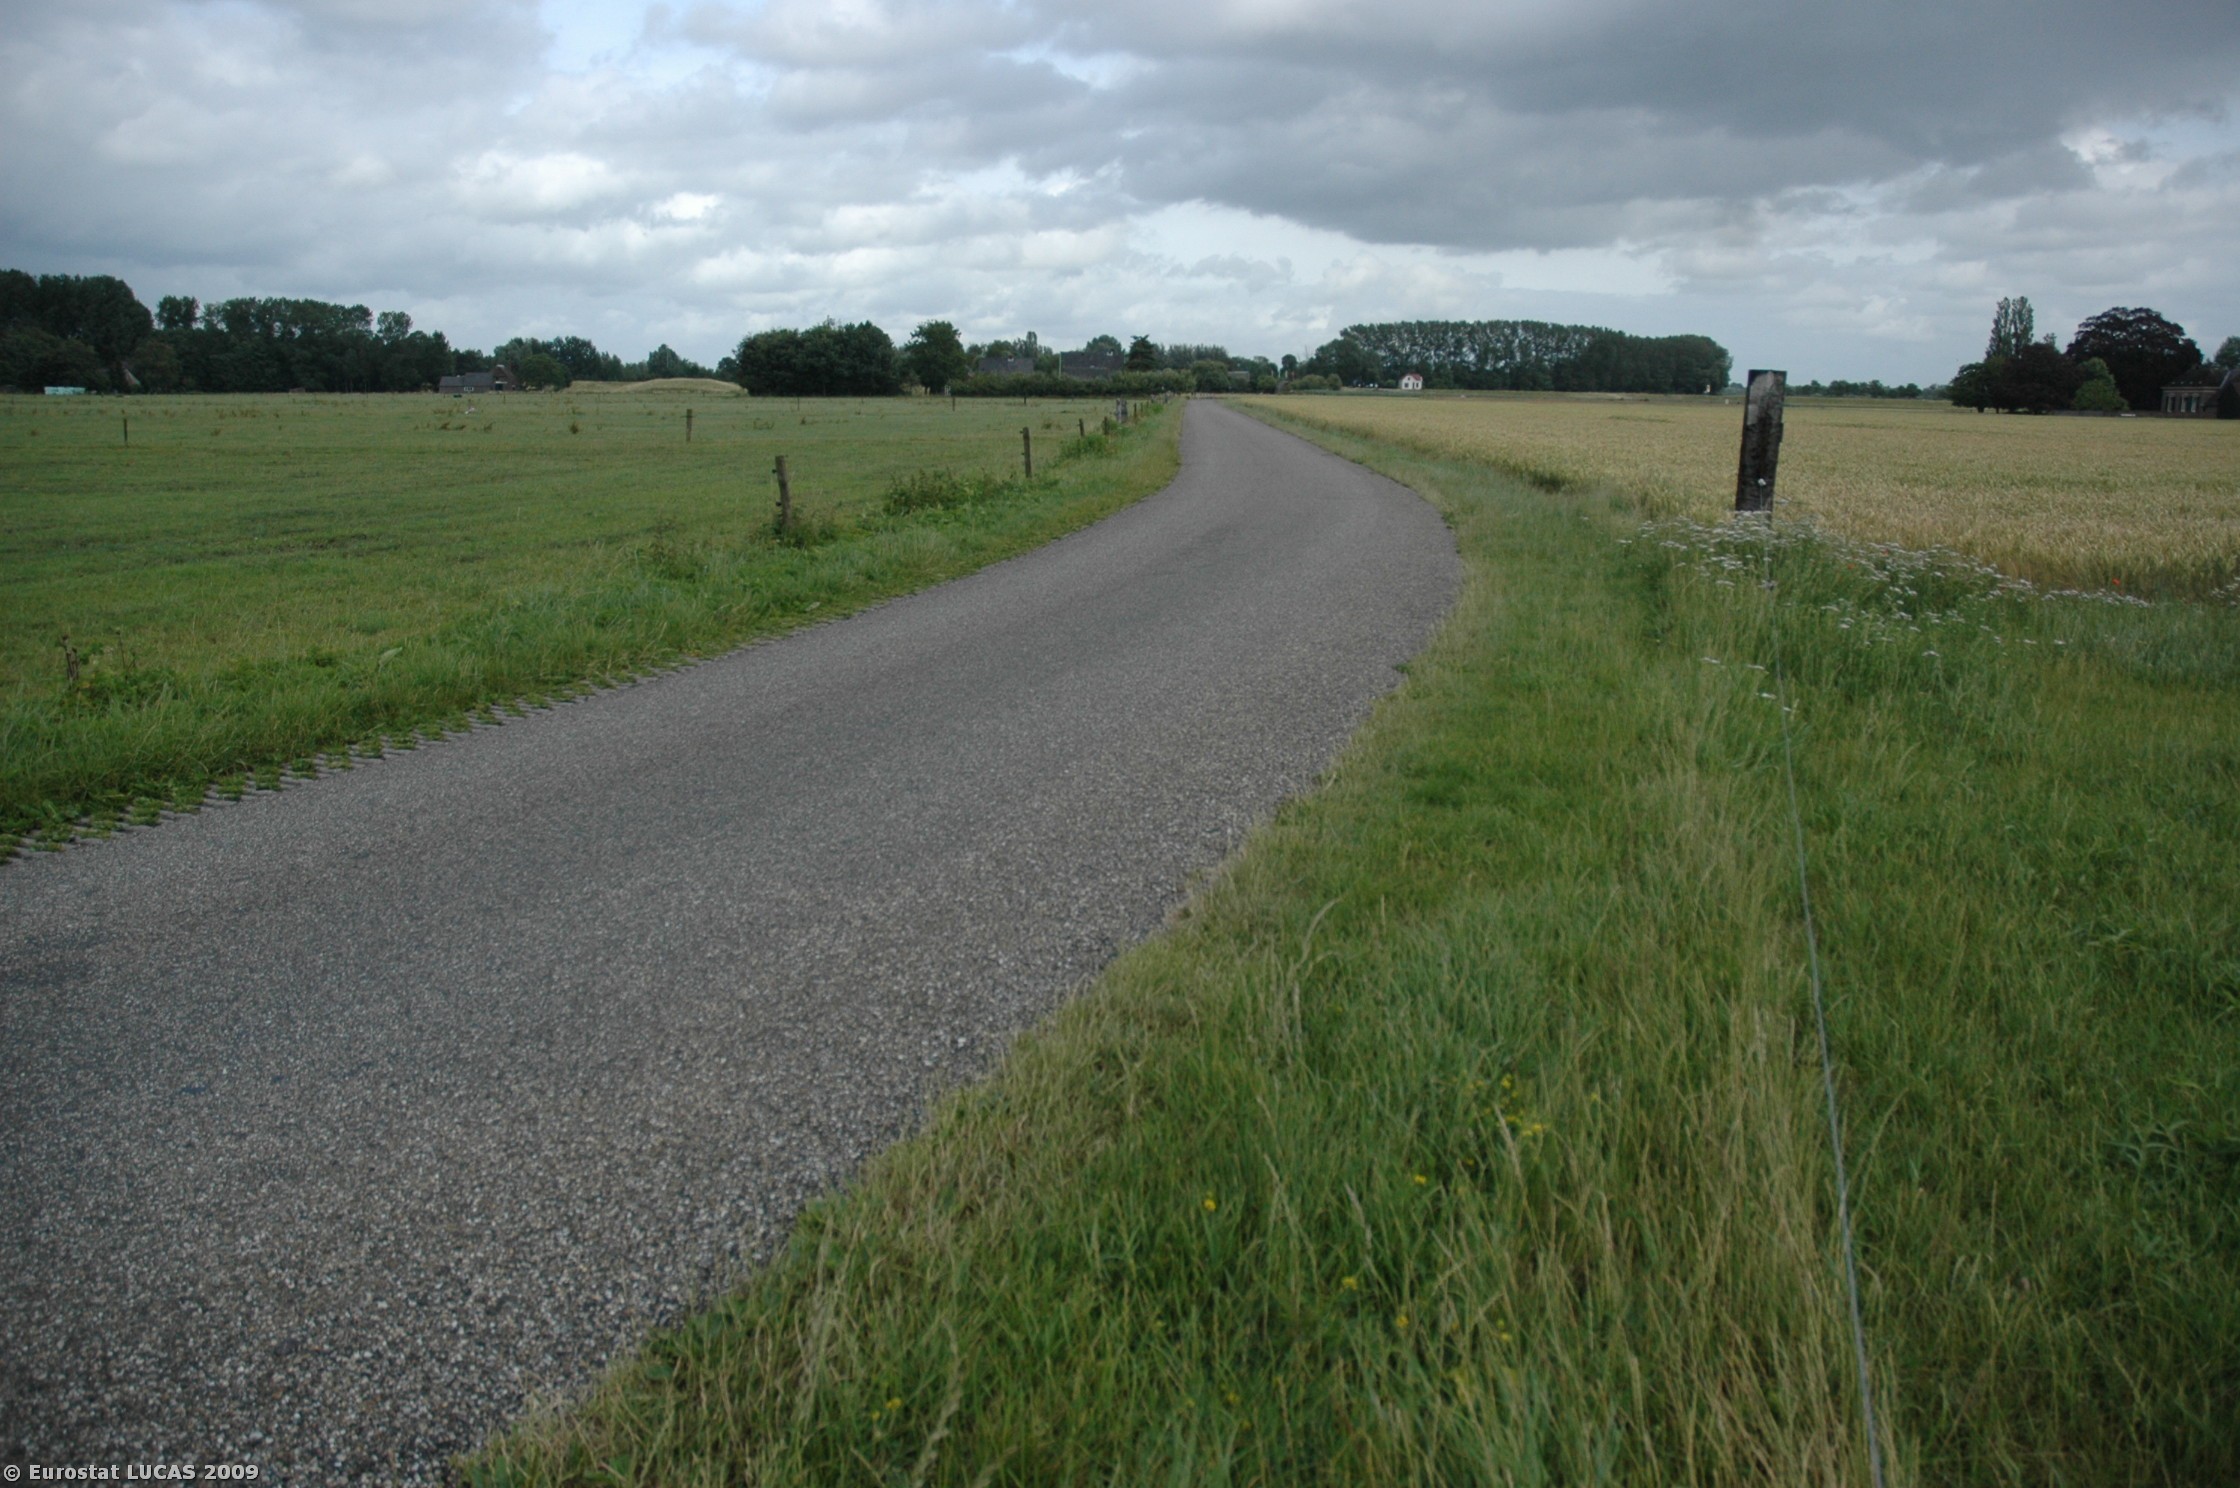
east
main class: Cropland
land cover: Common wheat
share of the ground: > 75 %
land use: Agriculture (excluding fallow land and kitchen gardens)
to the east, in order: Common wheat; Grass margins; Common wheat
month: July
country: NL
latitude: 52.2950
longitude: 6.0844
